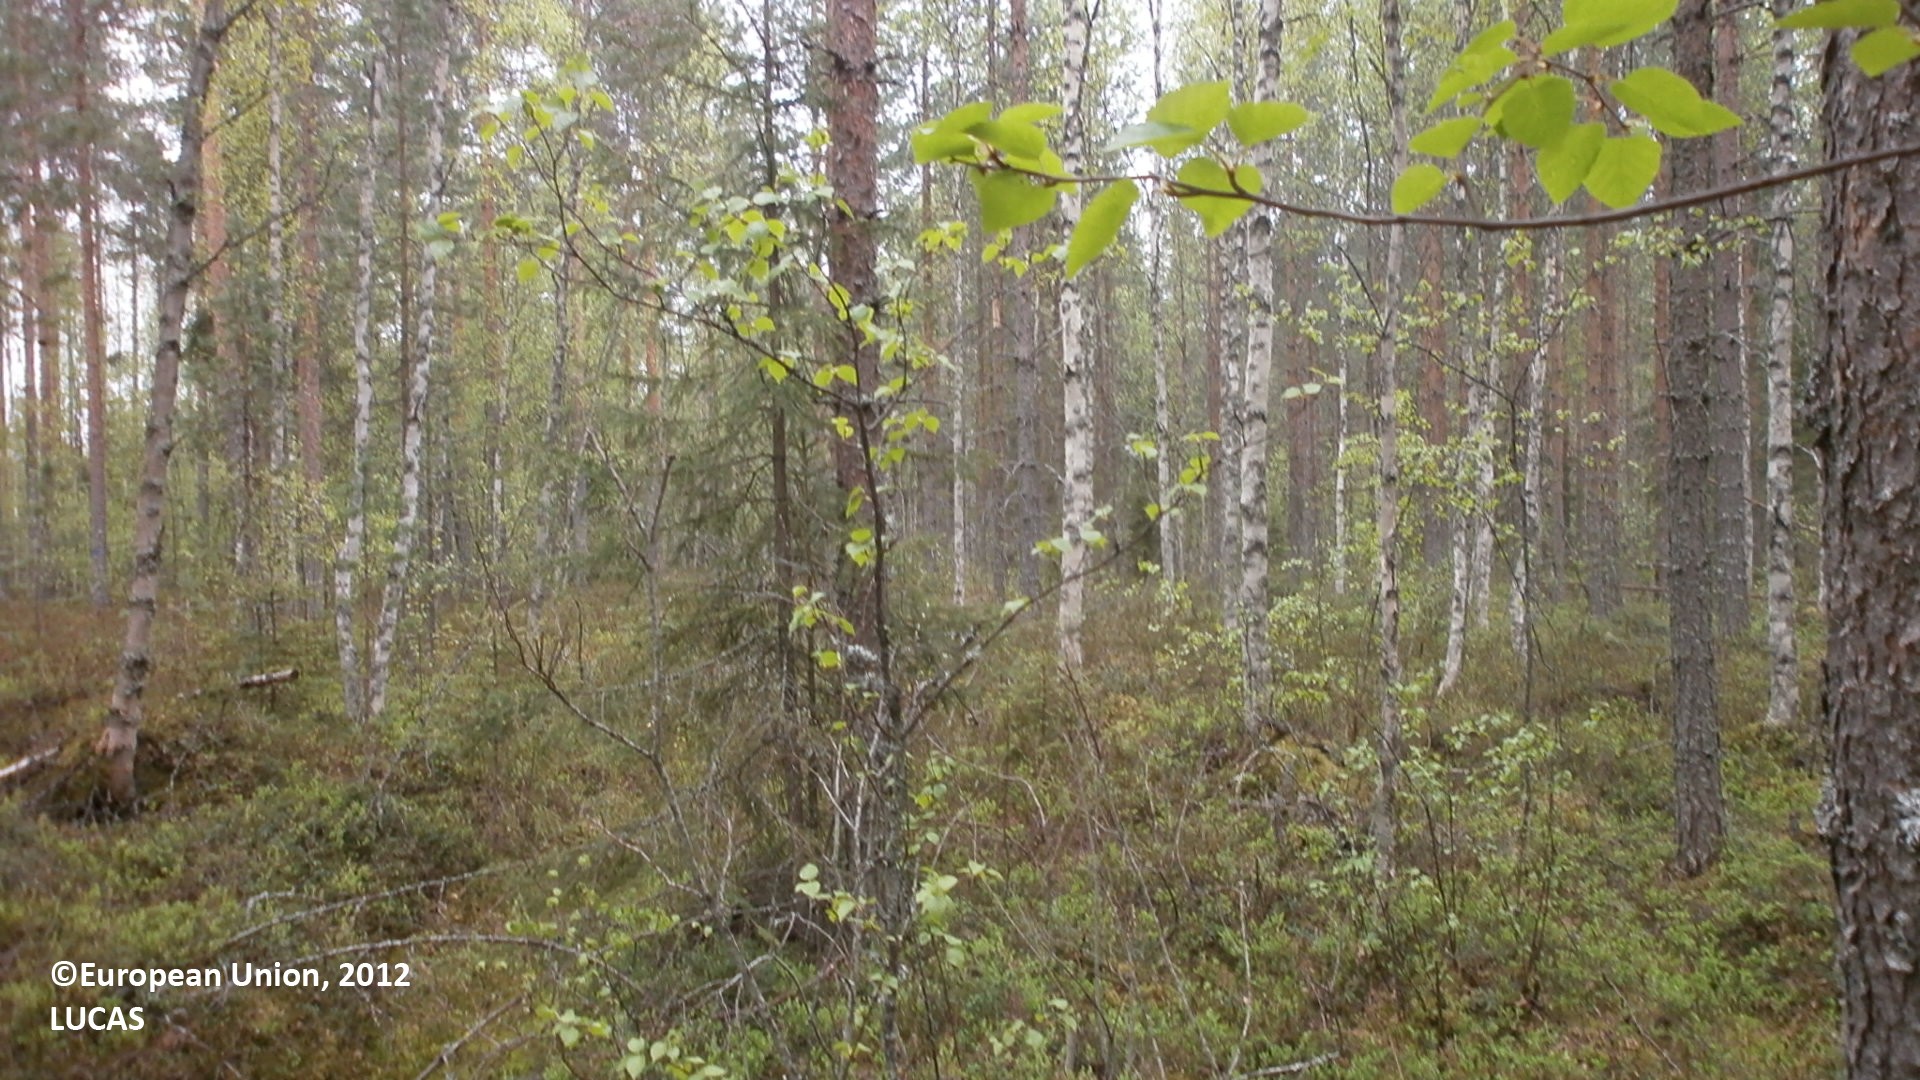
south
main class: Woodland
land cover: Pine dominated mixed woodland
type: hemiboreal forest and nemoral coniferous forest and mixed broadleaved-coniferous forest
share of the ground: 50 - 75 %
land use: Forestry
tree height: > 5 m
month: June
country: FI
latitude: 64.2953
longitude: 25.8678
